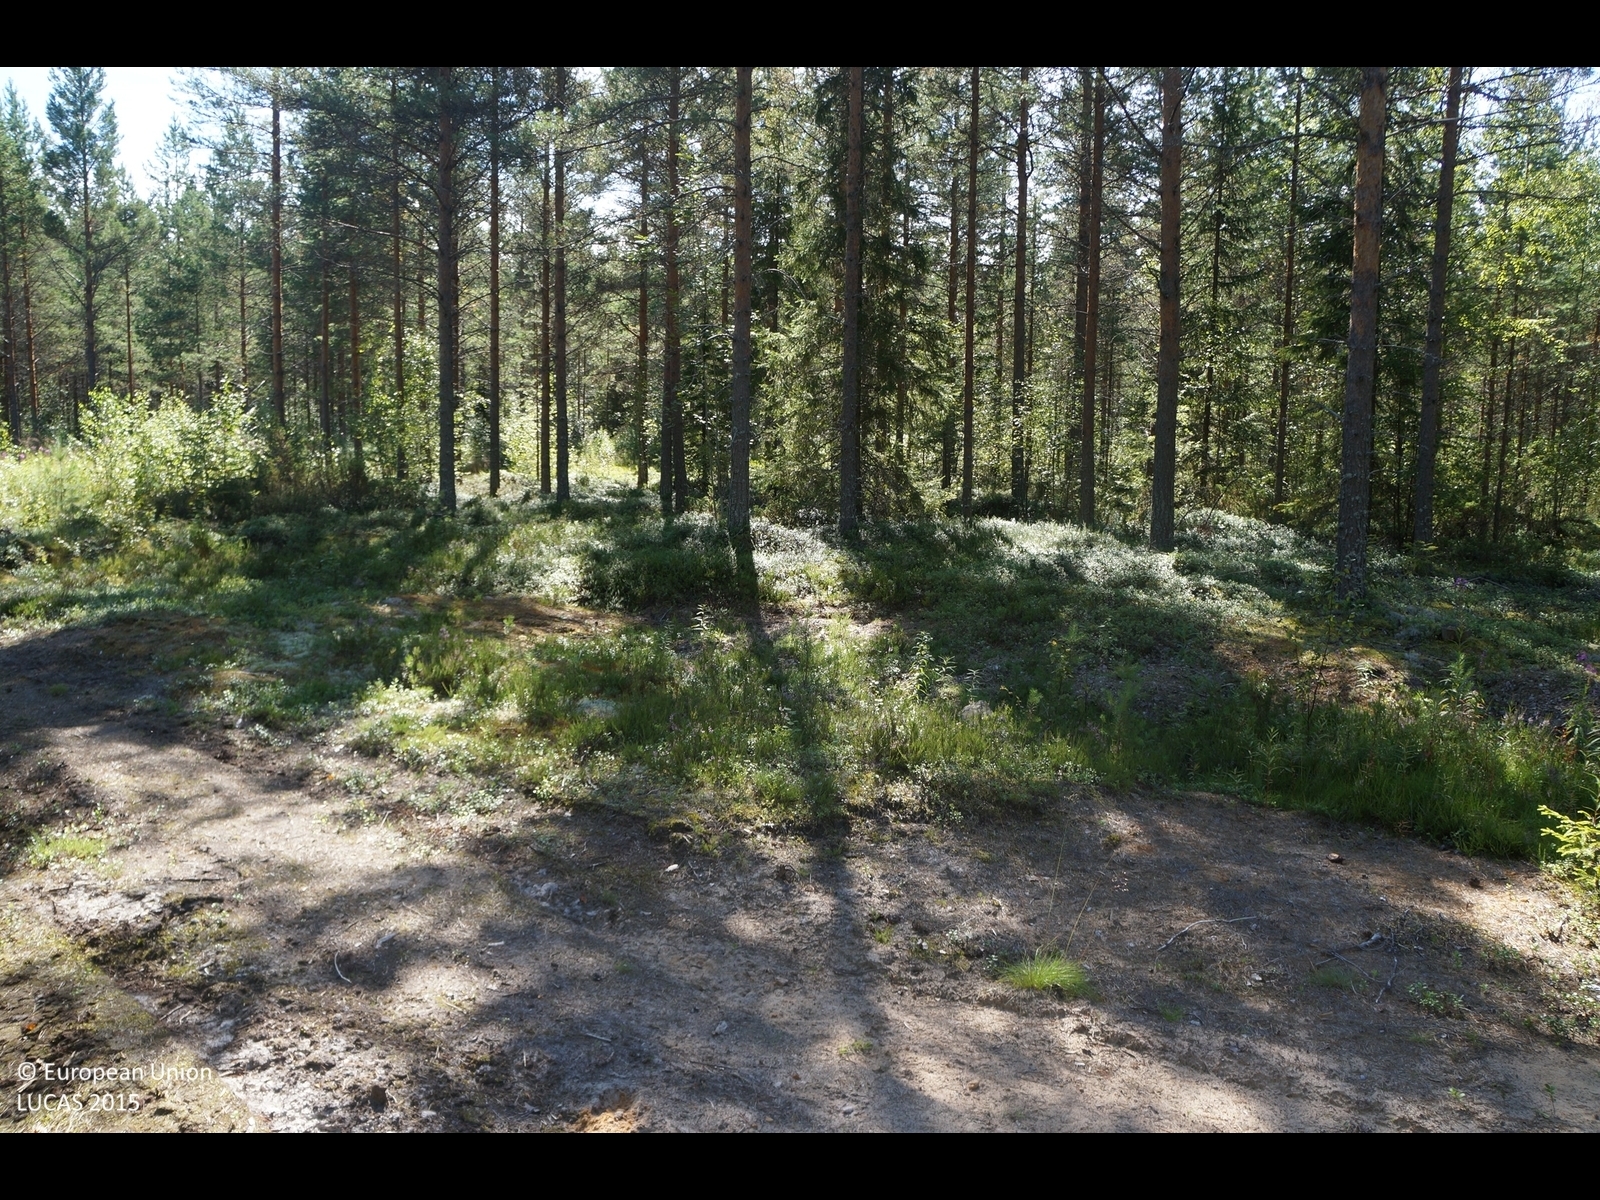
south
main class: Woodland
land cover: Pine dominated coniferous woodland
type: boreal forest
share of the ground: 50 - 75 %
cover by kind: coniferous forest trees 60 %, shrubs 30 %, lichens and mosses 10 %
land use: Forestry
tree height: > 5 m
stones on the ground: < 10 %
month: August
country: FI
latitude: 64.5961
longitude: 24.6748
